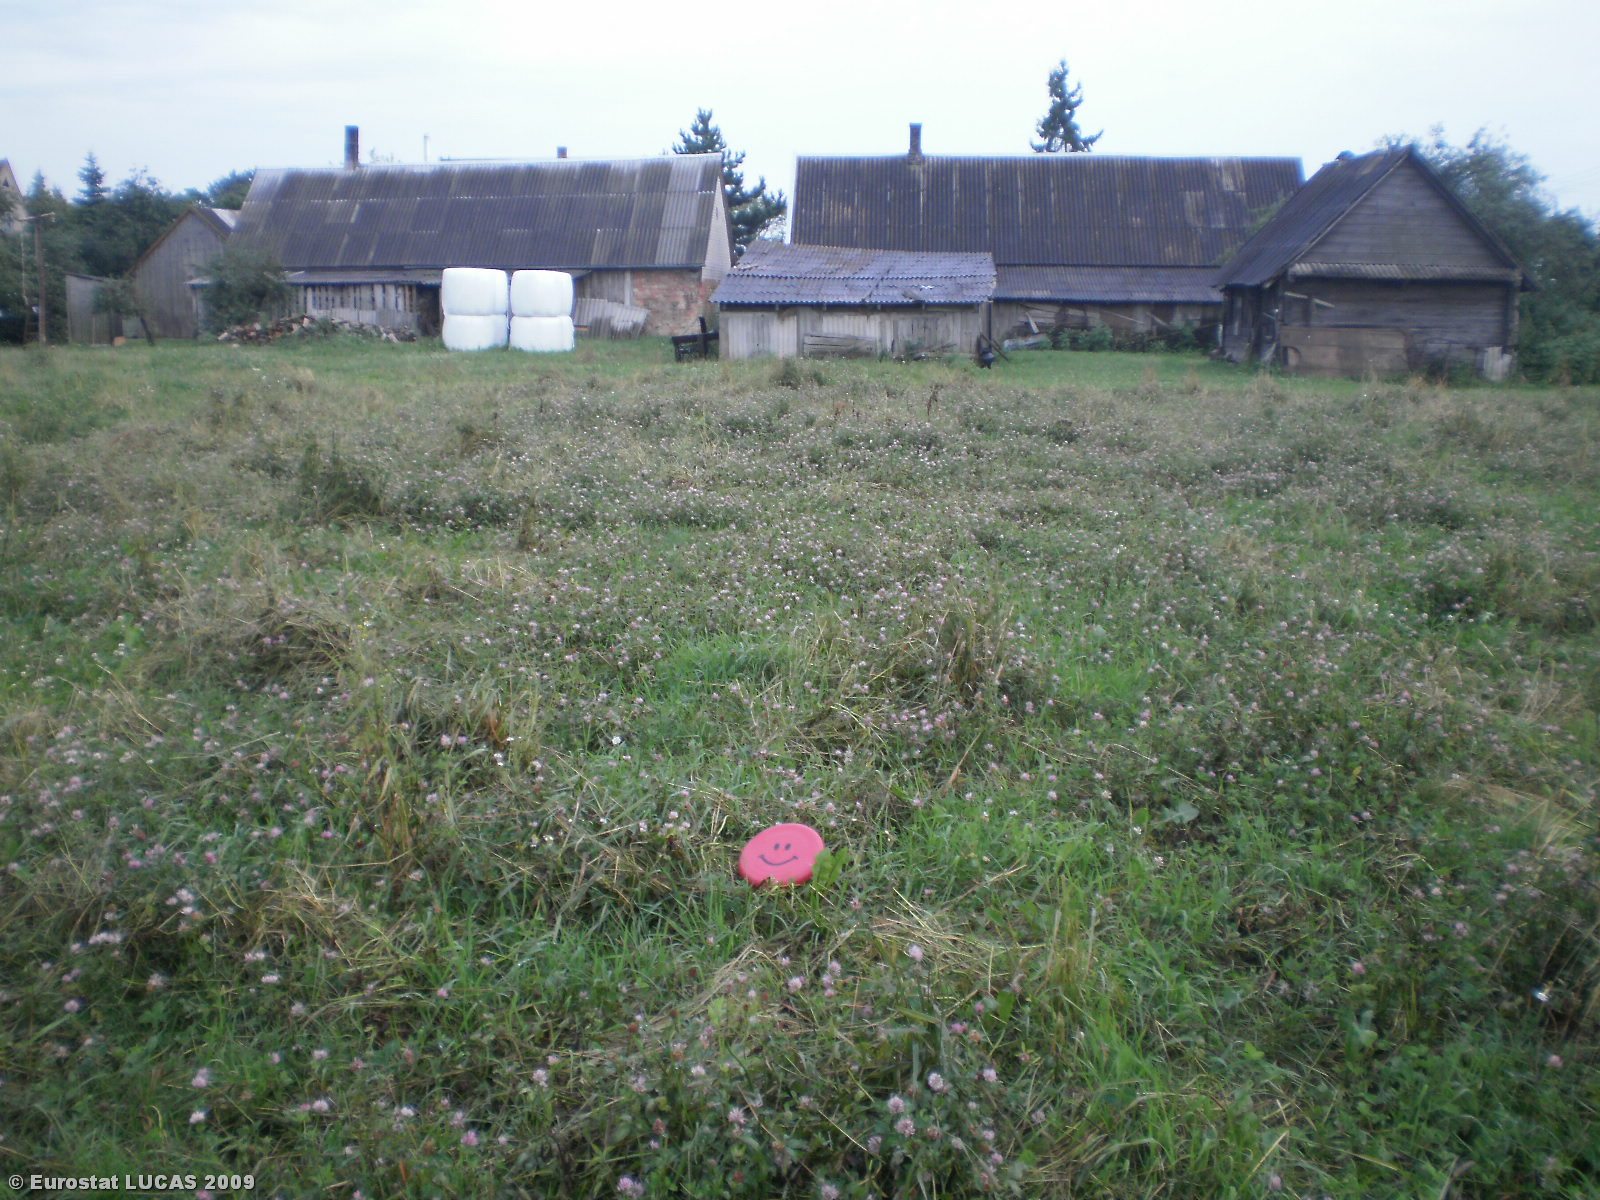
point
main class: Cropland
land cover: Clovers
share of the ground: > 75 %
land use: Agriculture (excluding fallow land and kitchen gardens)
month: July
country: LT
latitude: 55.8656
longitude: 24.8558
